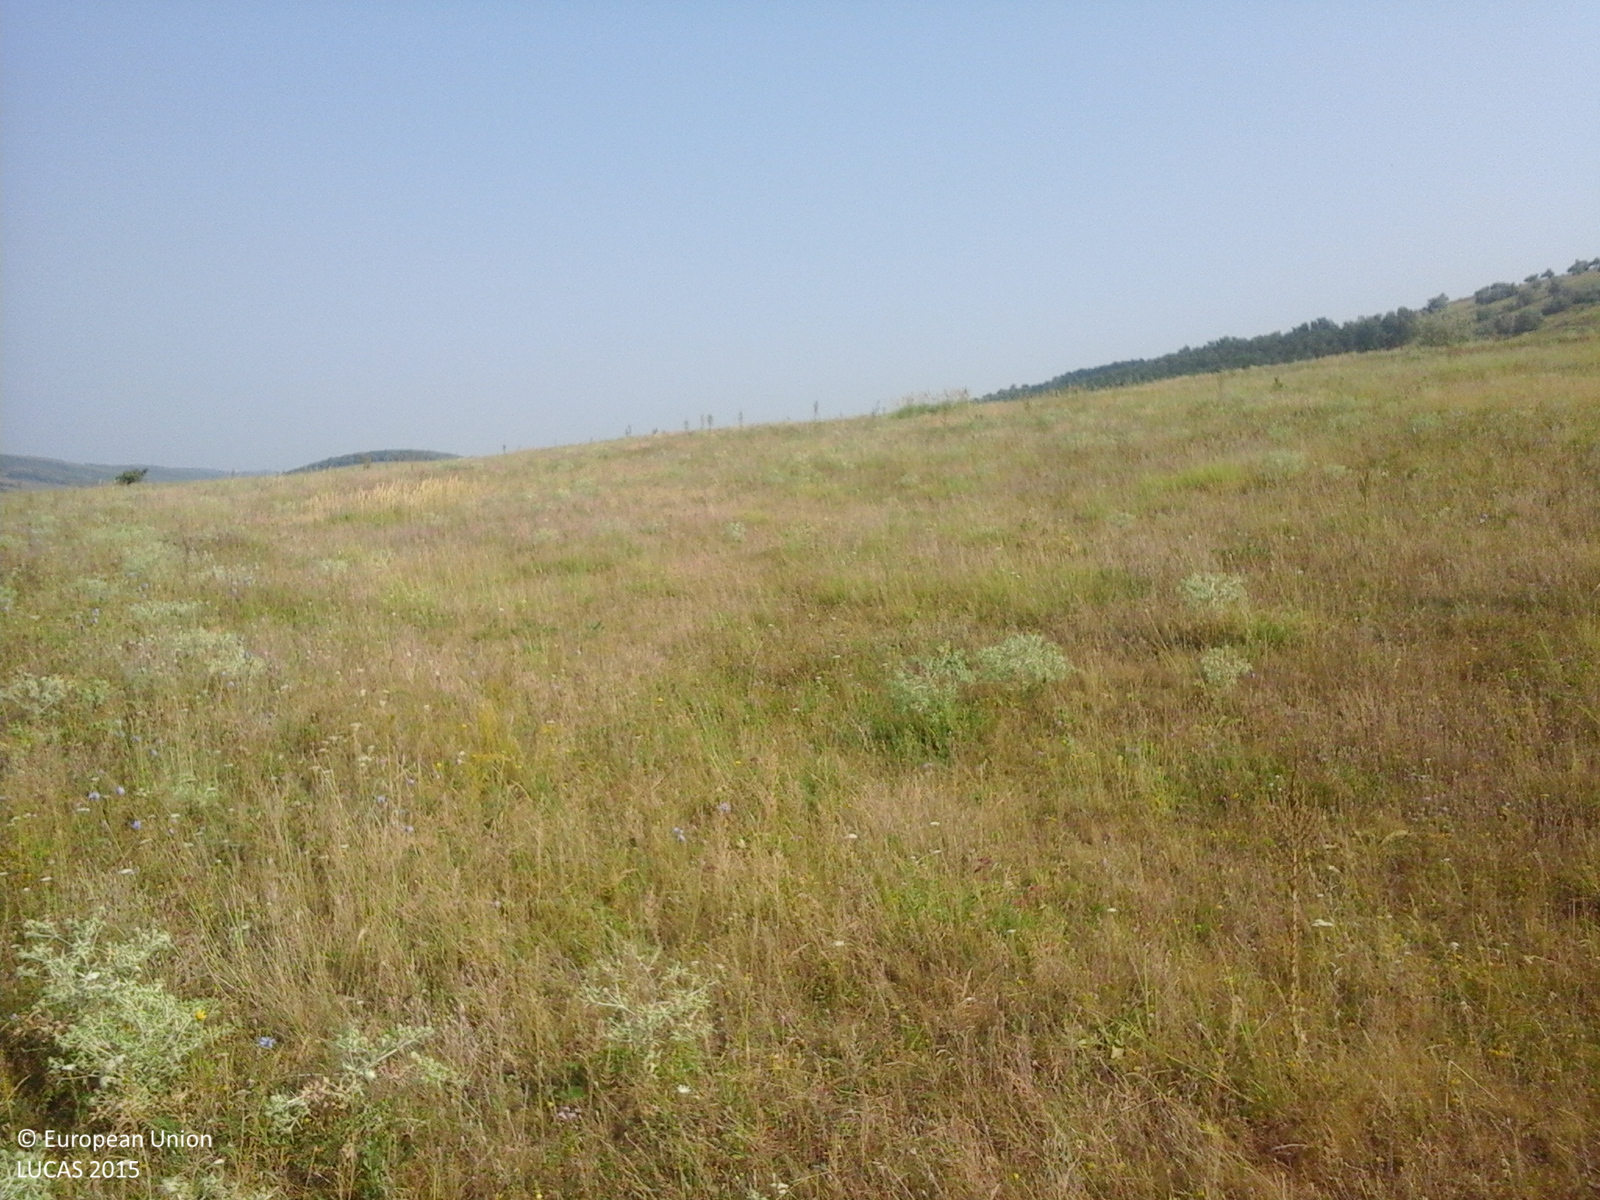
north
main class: Grassland
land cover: Grassland with sparse tree/shrub cover
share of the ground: > 75 %
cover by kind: herbaceous plants 95 %, broadleaved forest trees 5 %
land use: Agriculture (excluding fallow land and kitchen gardens)
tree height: > 5 m
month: July
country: RO
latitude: 46.4740
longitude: 27.6319
